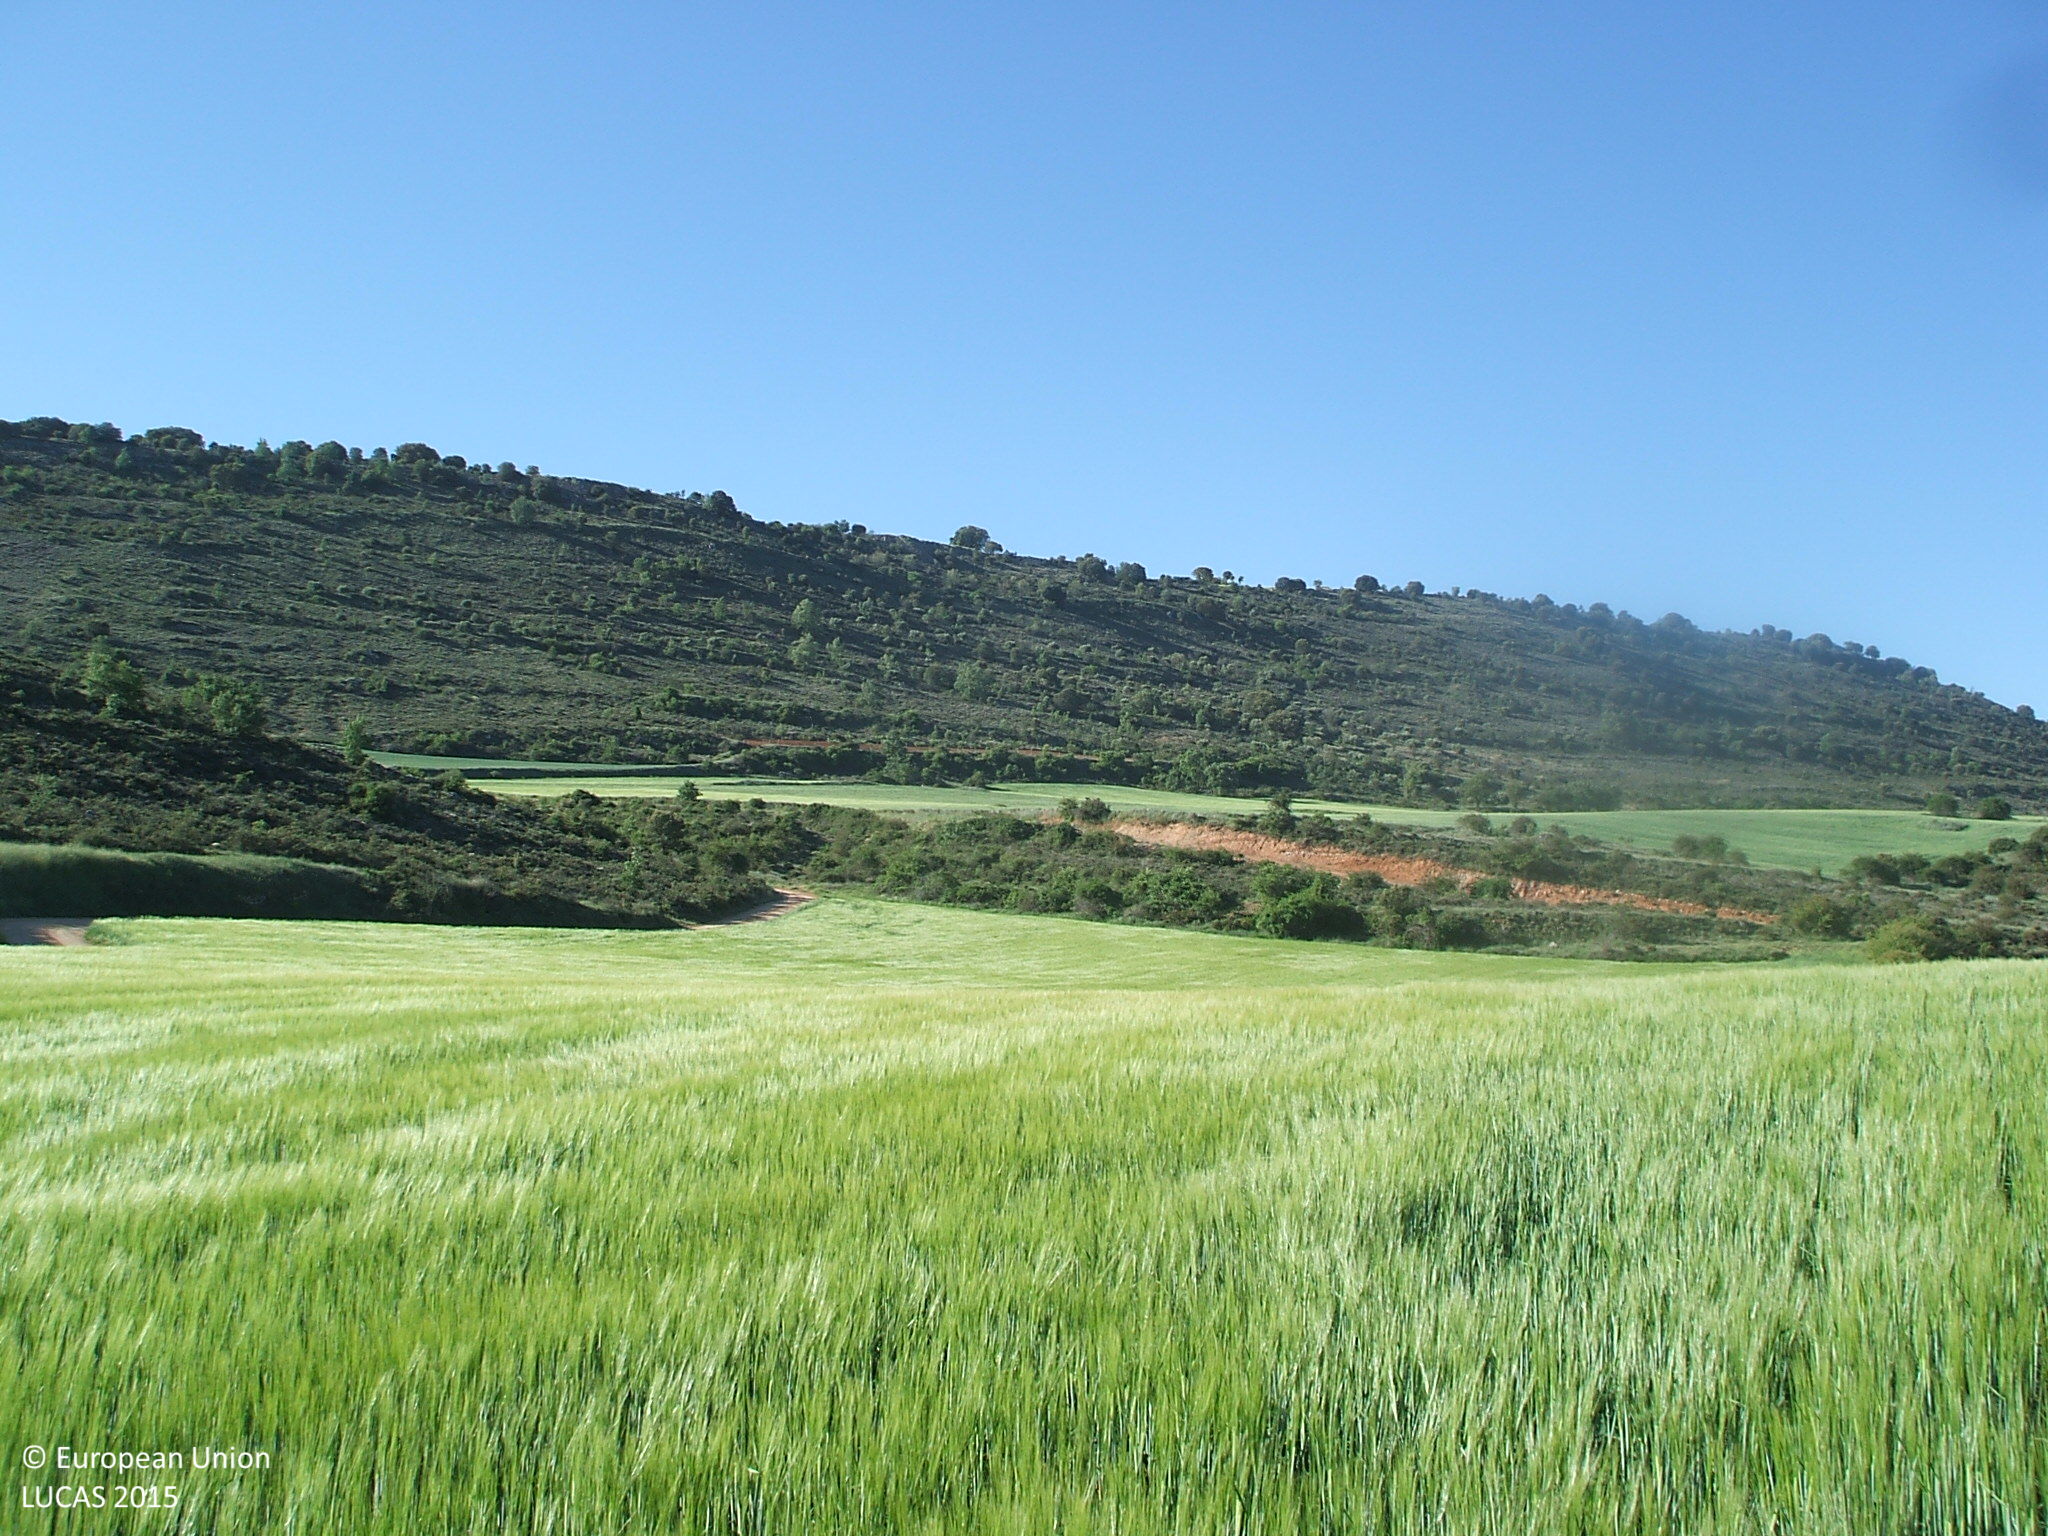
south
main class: Cropland
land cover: Barley
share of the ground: > 75 %
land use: Agriculture (excluding fallow land and kitchen gardens)
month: May
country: ES
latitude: 40.7525
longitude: -2.8586
